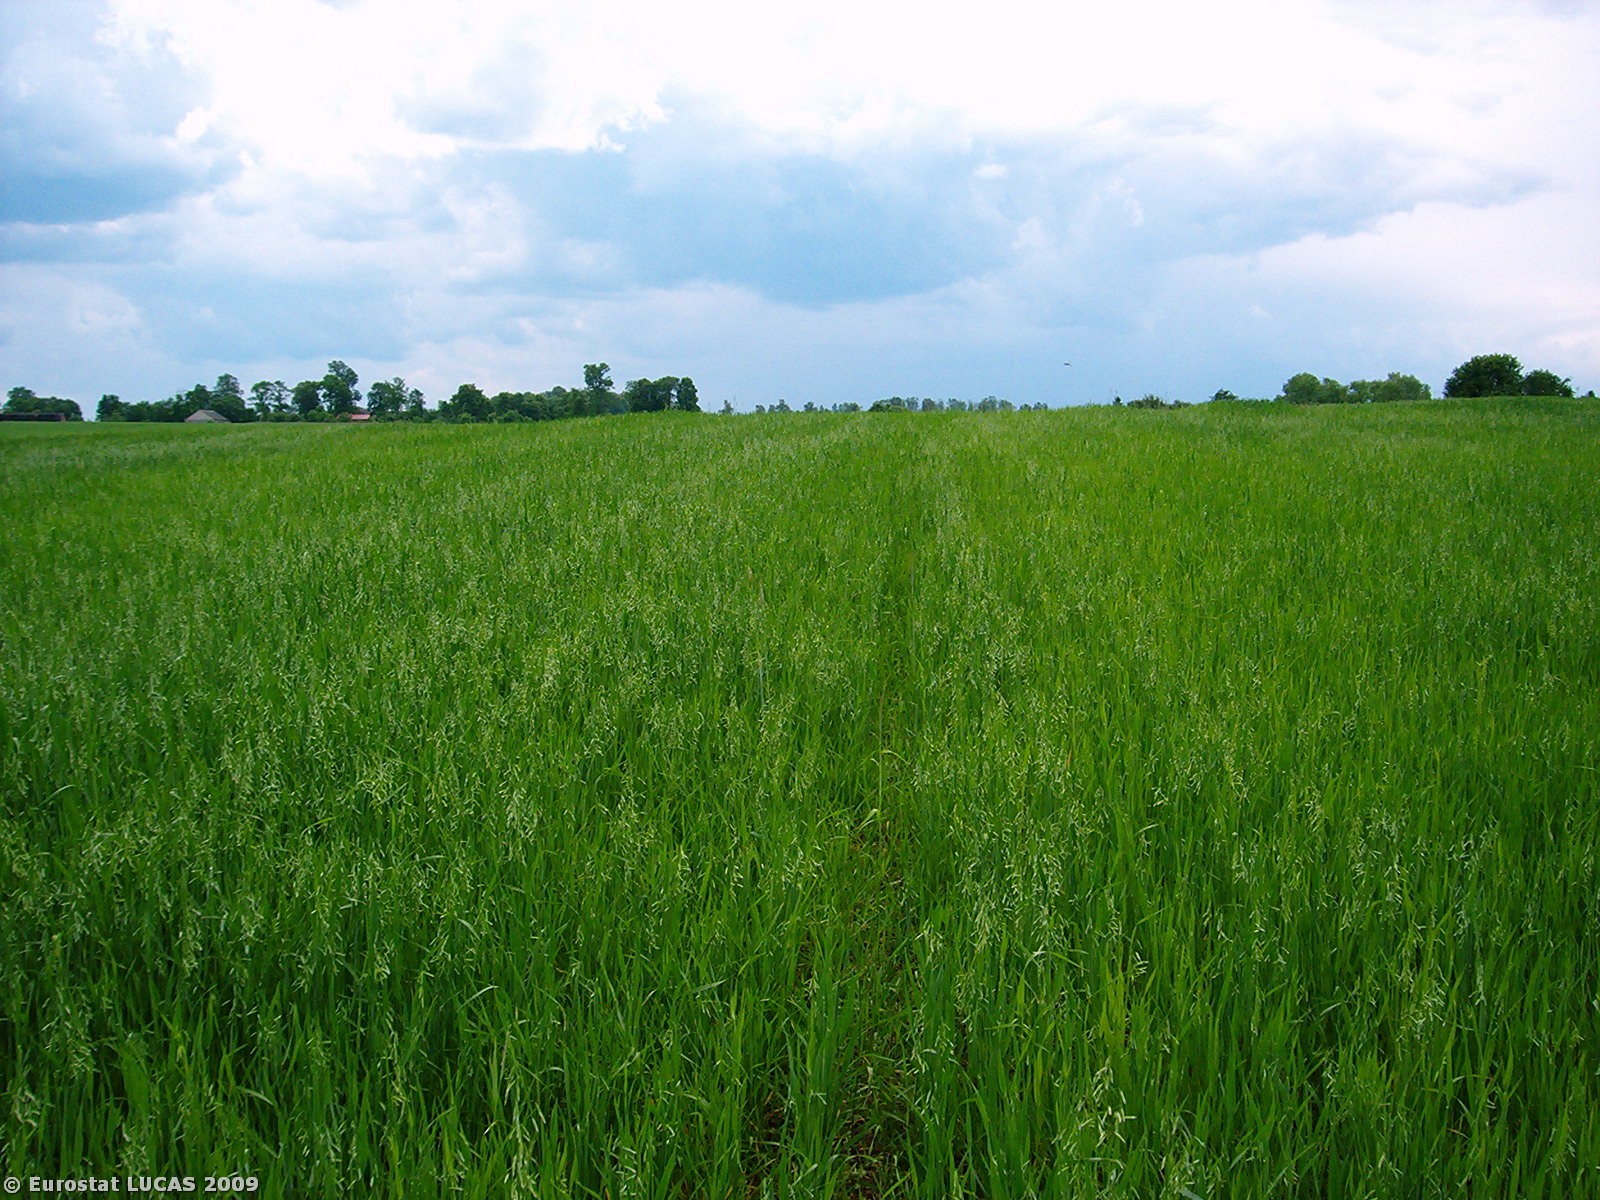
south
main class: Cropland
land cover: Oats
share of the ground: > 75 %
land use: Agriculture (excluding fallow land and kitchen gardens)
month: June
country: PL
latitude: 53.6230
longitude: 17.1612
